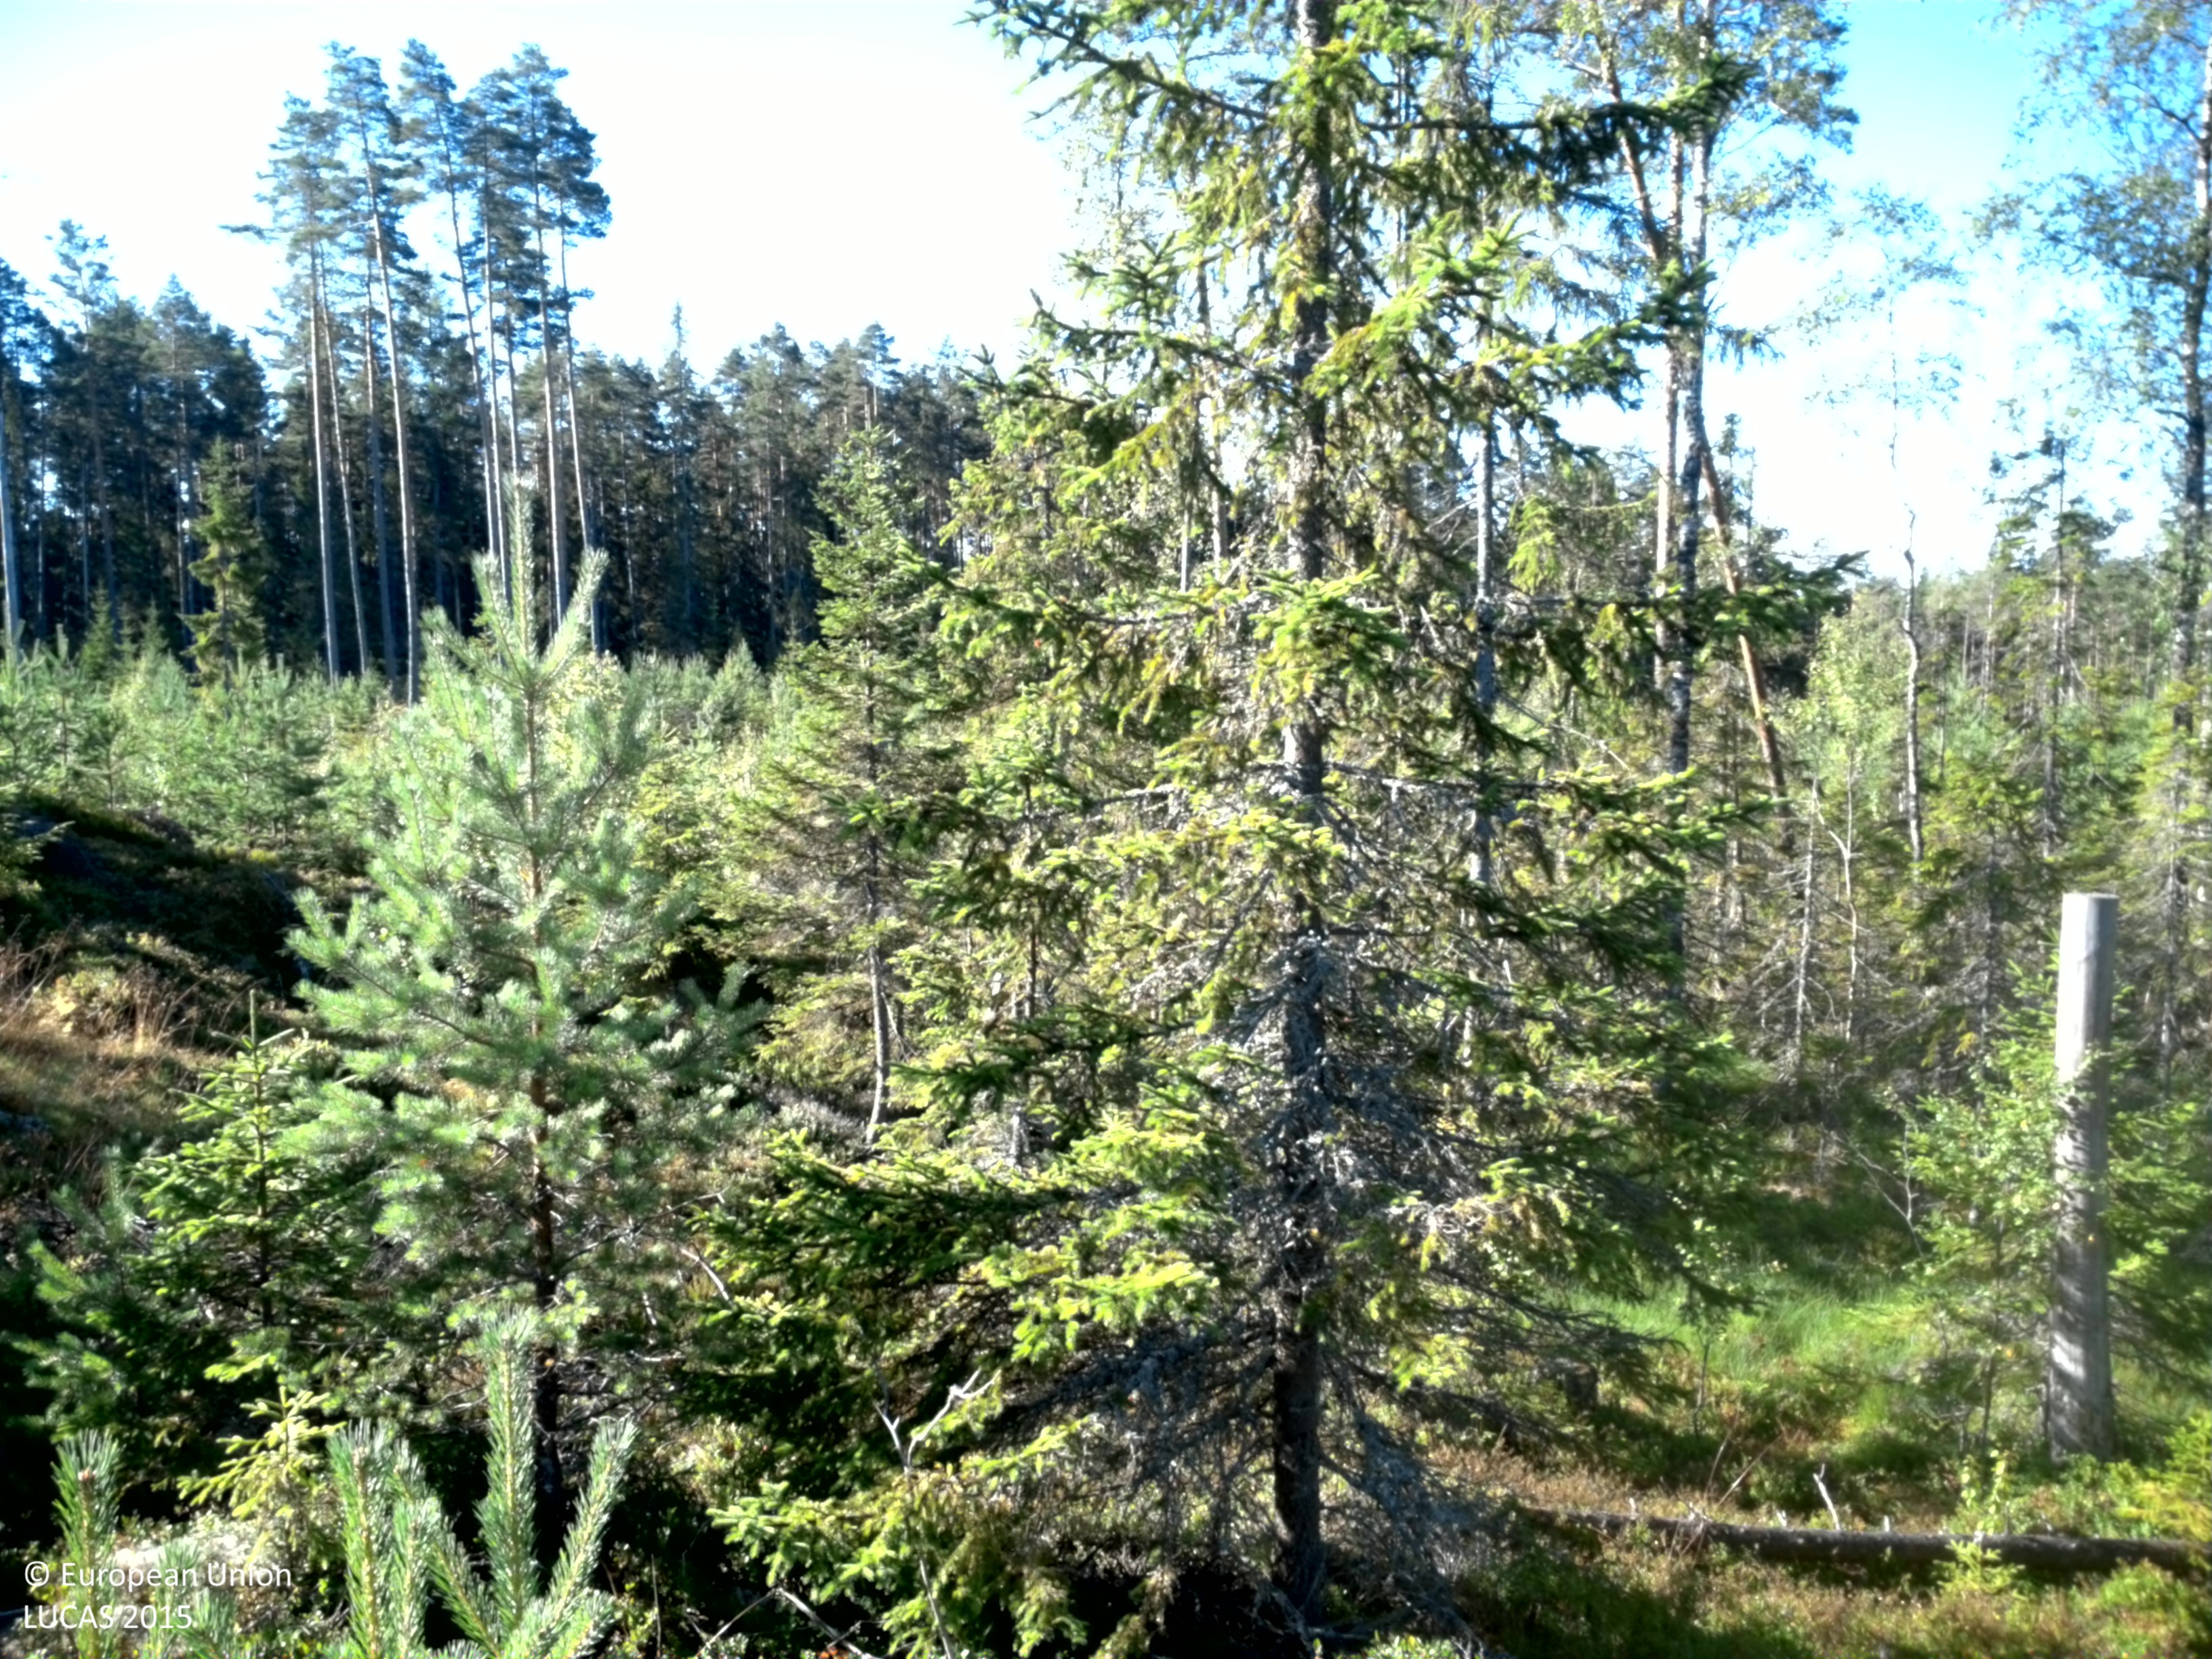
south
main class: Woodland
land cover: Other mixed woodland
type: boreal forest
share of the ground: 50 - 75 %
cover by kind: coniferous forest trees 40 %, broadleaved forest trees 25 %, shrubs 25 %, lichens and mosses 10 %
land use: Forestry
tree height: < 5 m
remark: Clear cut
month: August
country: SE
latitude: 60.0310
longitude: 14.0998
